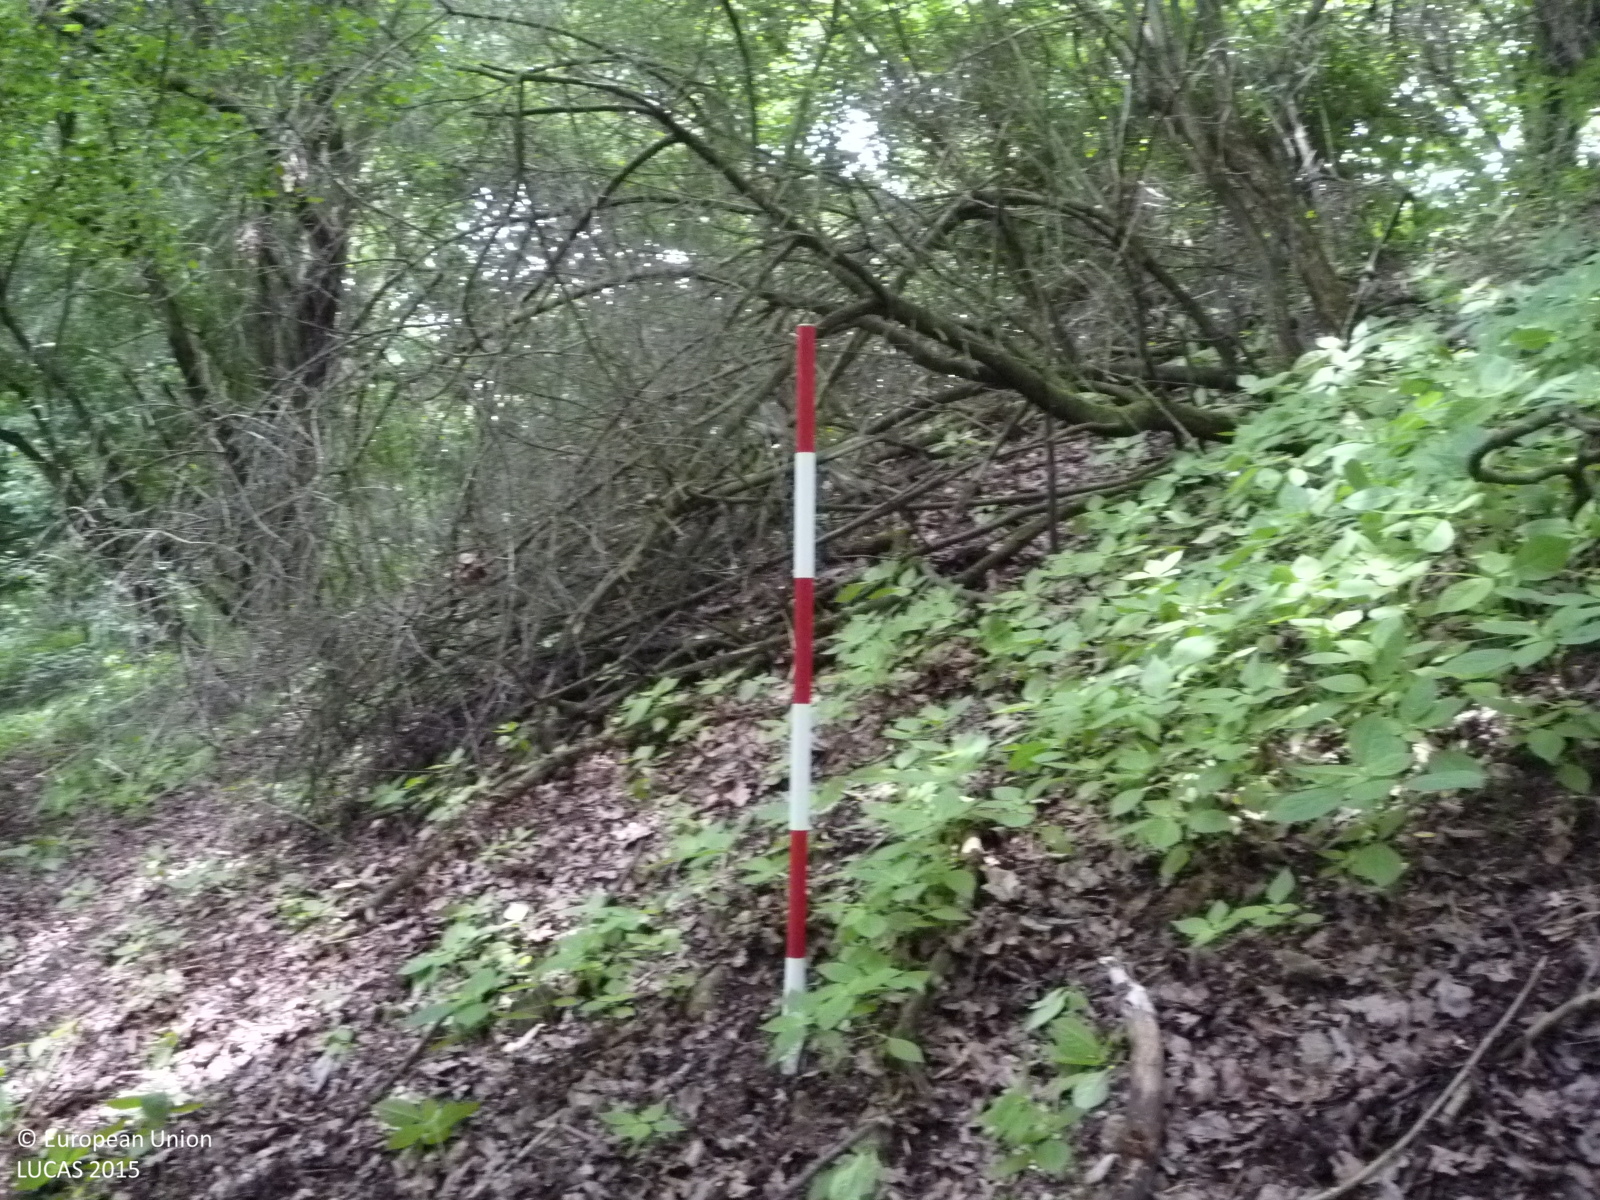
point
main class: Woodland
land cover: Broadleaved woodland
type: non-riverine alder, birch or aspen forest
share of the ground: > 75 %
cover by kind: broadleaved forest trees 75 %, coniferous forest trees 20 %, shrubs 5 %
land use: Semi-natural and natural areas not in use
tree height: > 5 m
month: June
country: CZ
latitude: 49.8678
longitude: 15.1926
